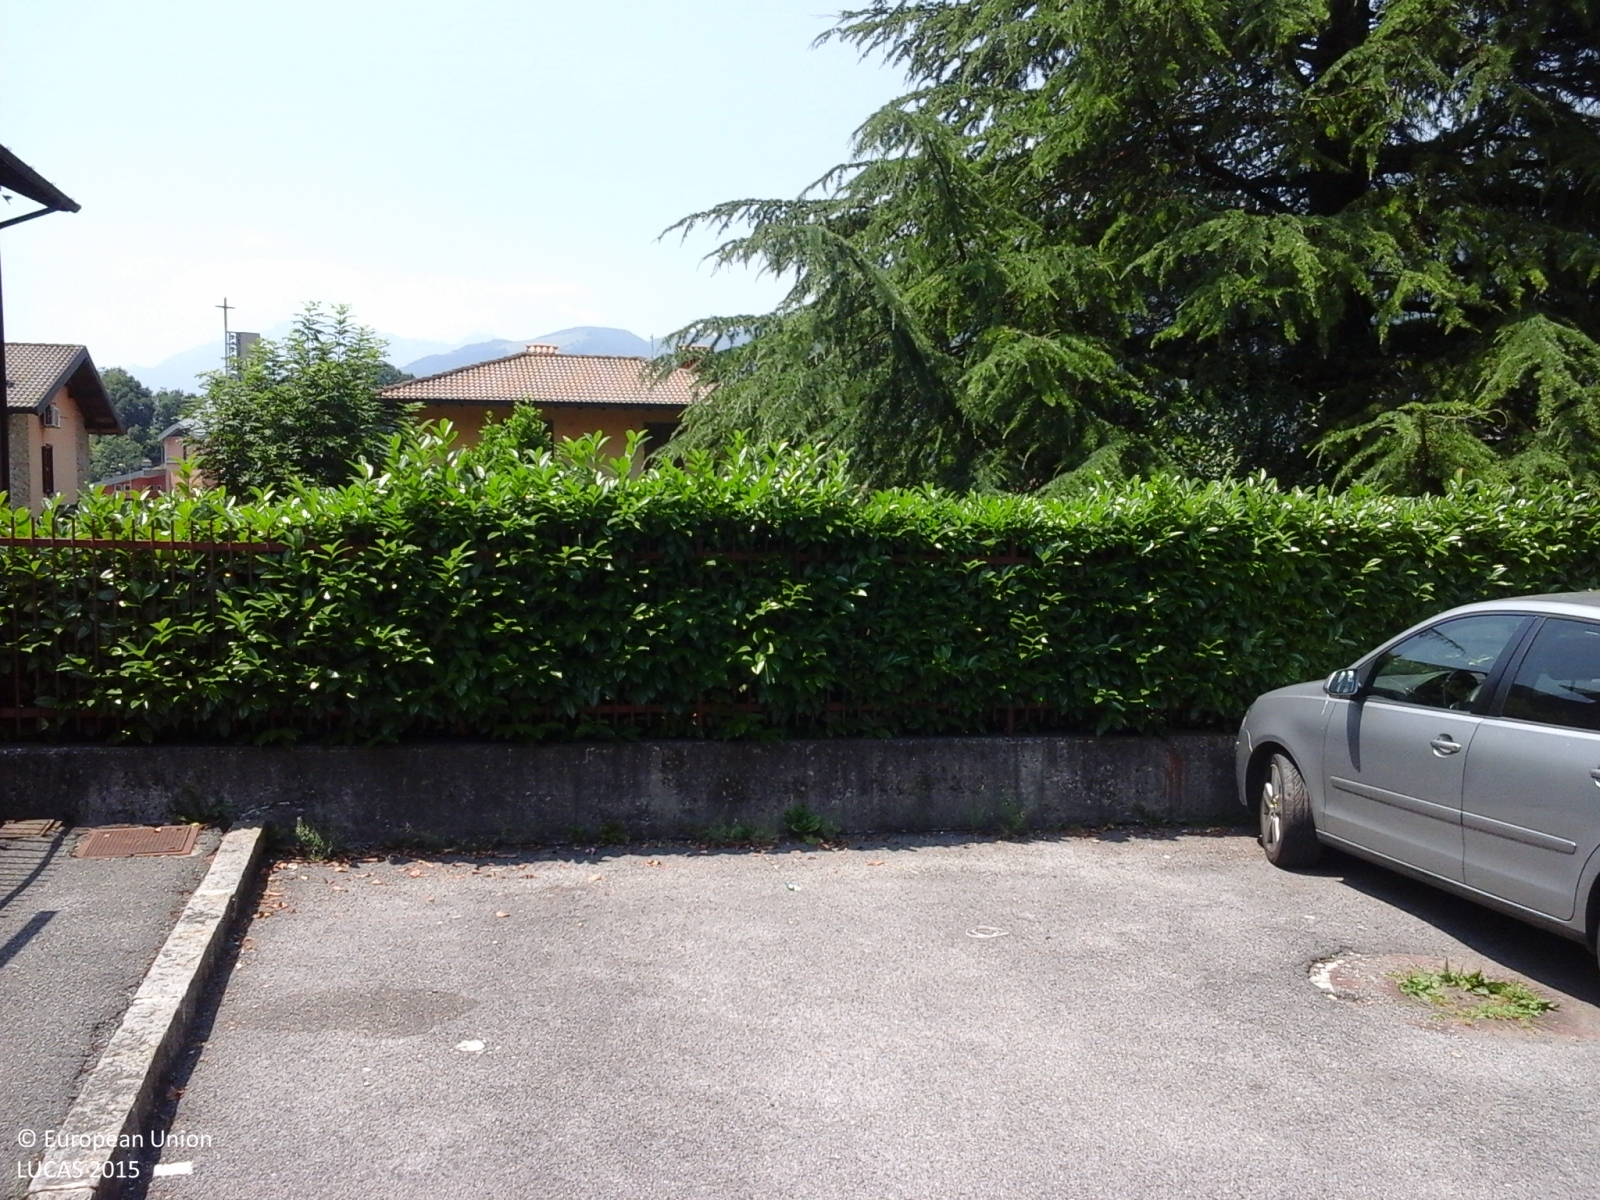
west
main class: Grassland
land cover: Grassland without tree/shrub cover
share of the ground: > 75 %
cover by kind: herbaceous plants 100 %
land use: Residential
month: July
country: IT
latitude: 45.8828
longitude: 9.9357
